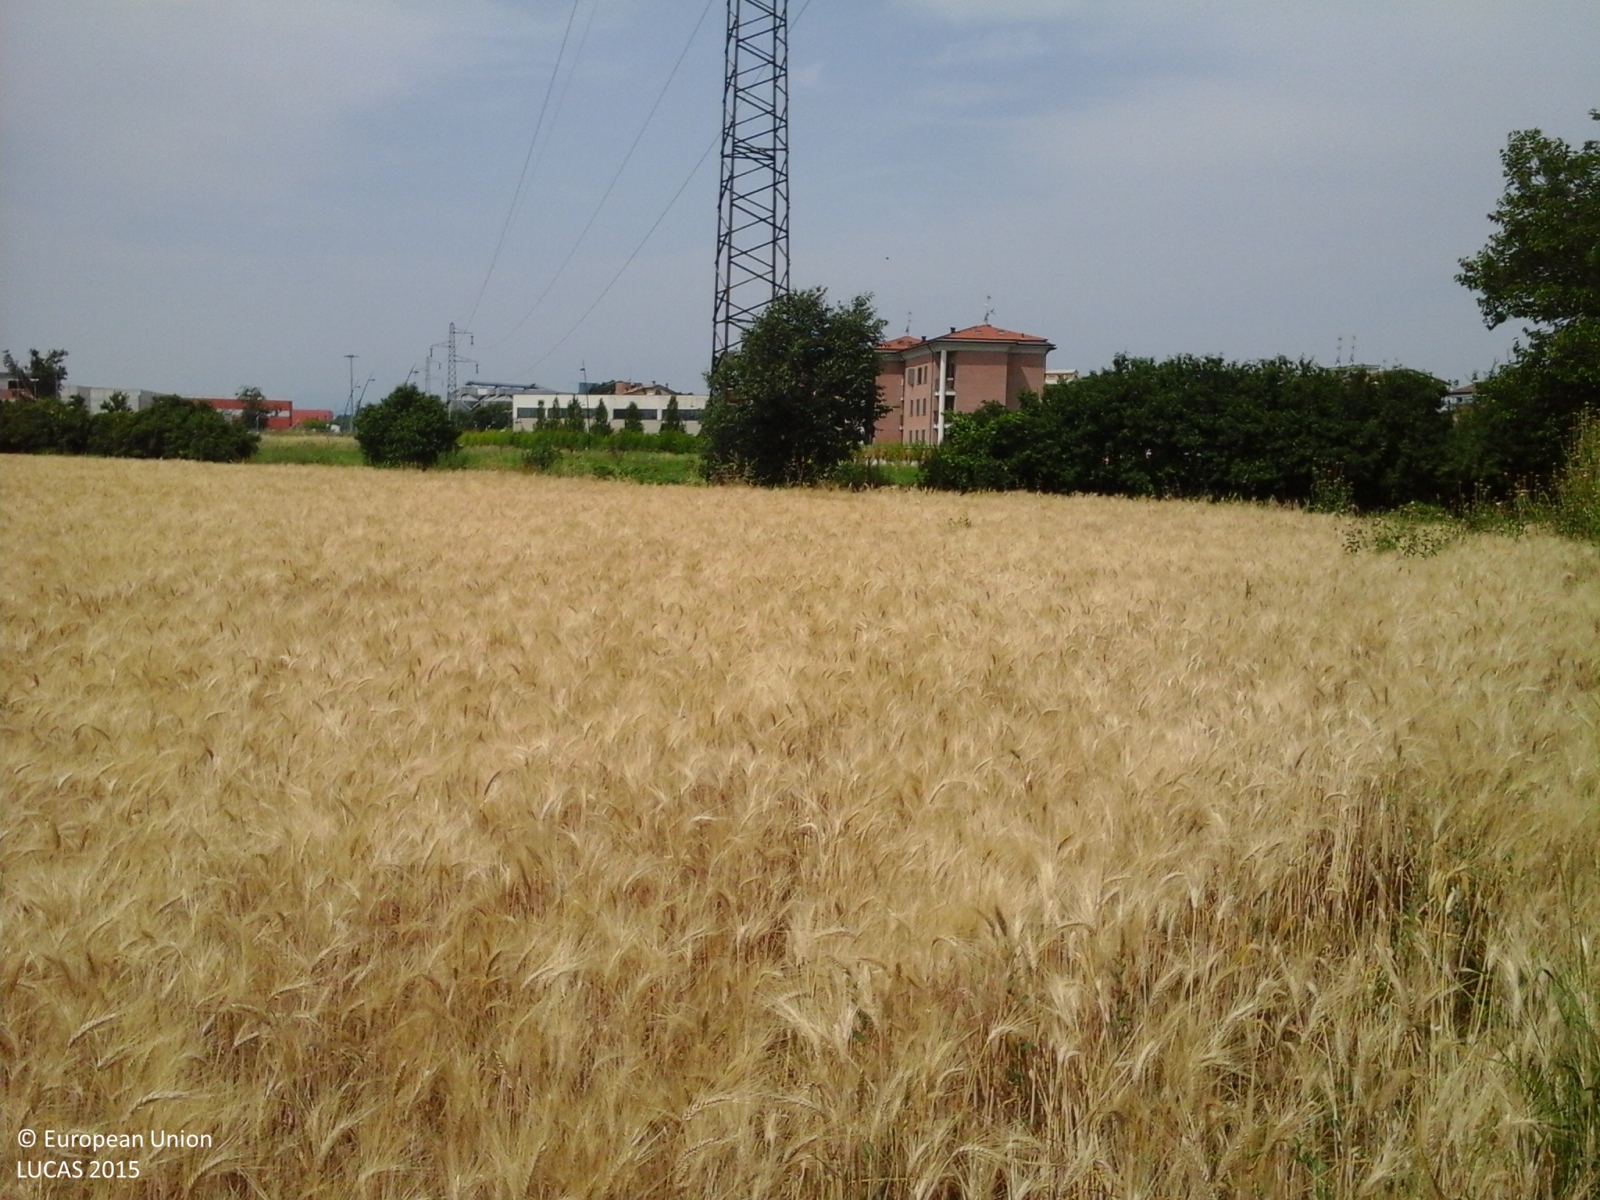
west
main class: Cropland
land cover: Common wheat
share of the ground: > 75 %
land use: Agriculture (excluding fallow land and kitchen gardens)
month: June
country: IT
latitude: 44.7830
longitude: 10.2648
